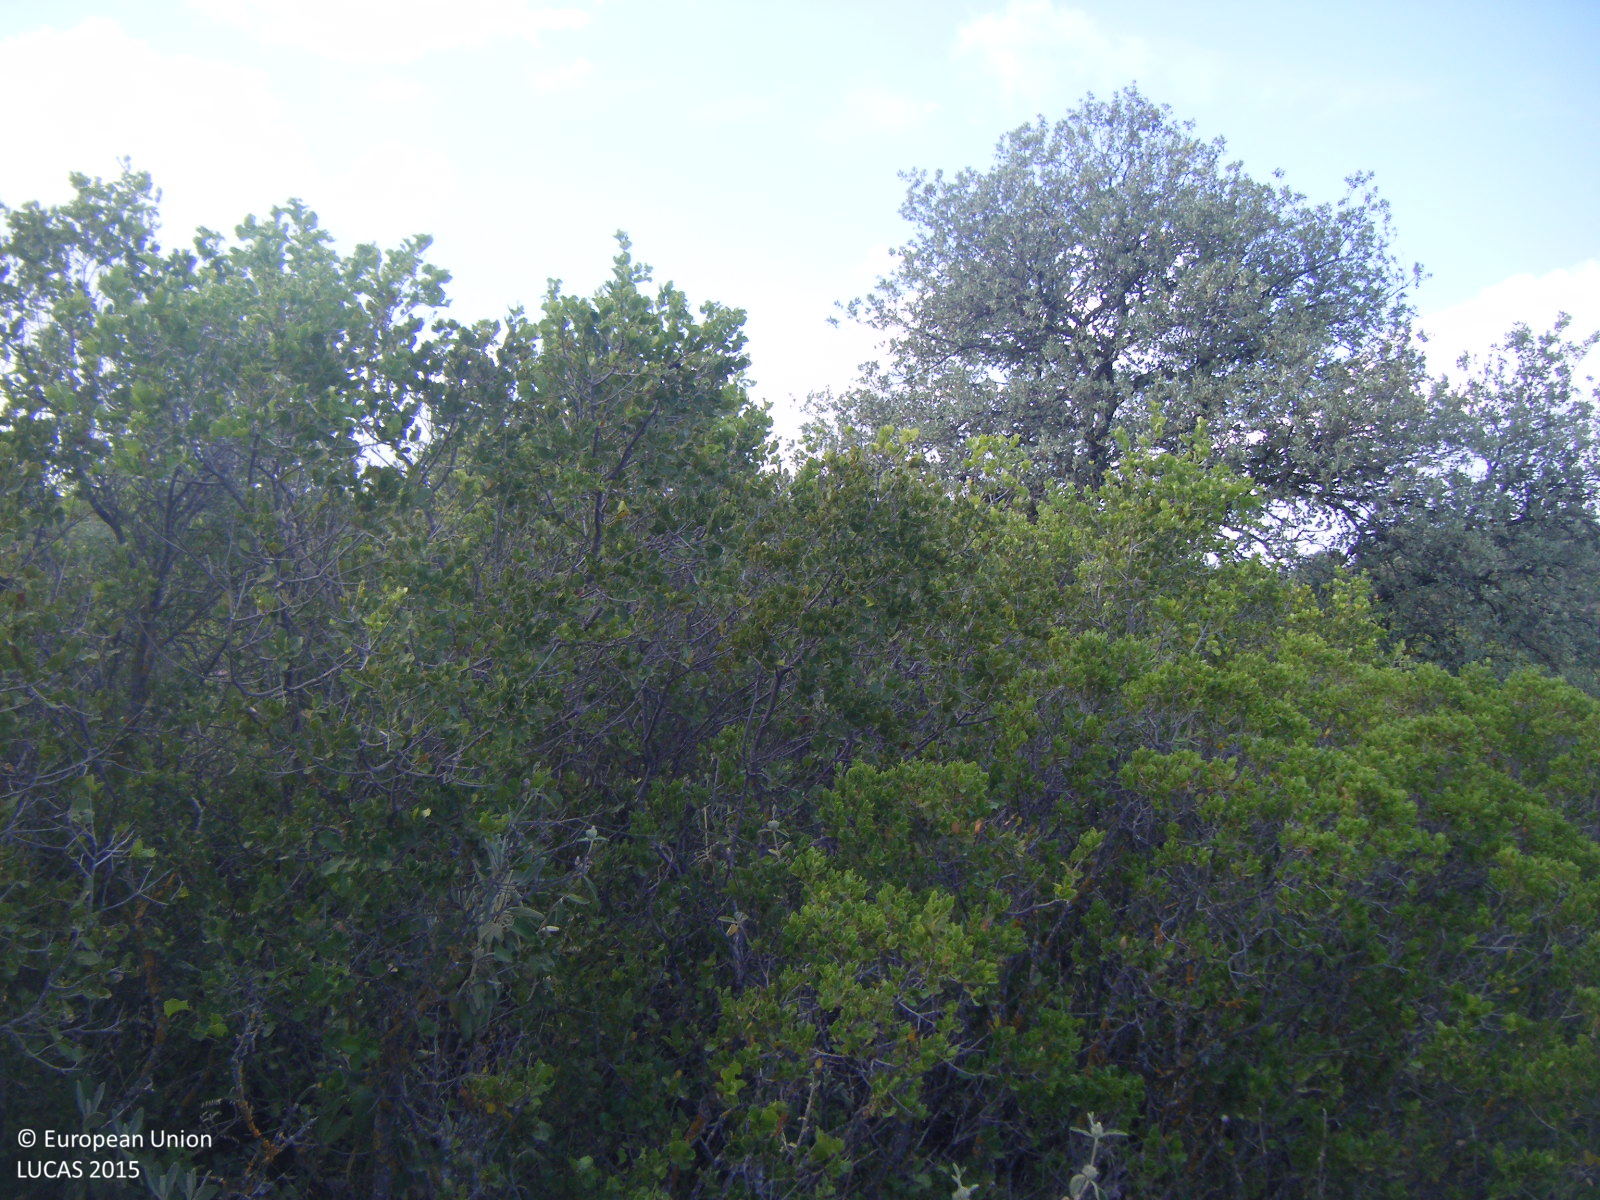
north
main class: Woodland
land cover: Broadleaved woodland
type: broadleaved evergreen forest
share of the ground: 10 - 25 %
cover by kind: shrubs 85 %, broadleaved forest trees 15 %
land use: Semi-natural and natural areas not in use
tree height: < 5 m
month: May
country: ES
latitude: 37.0322
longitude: -4.3957
